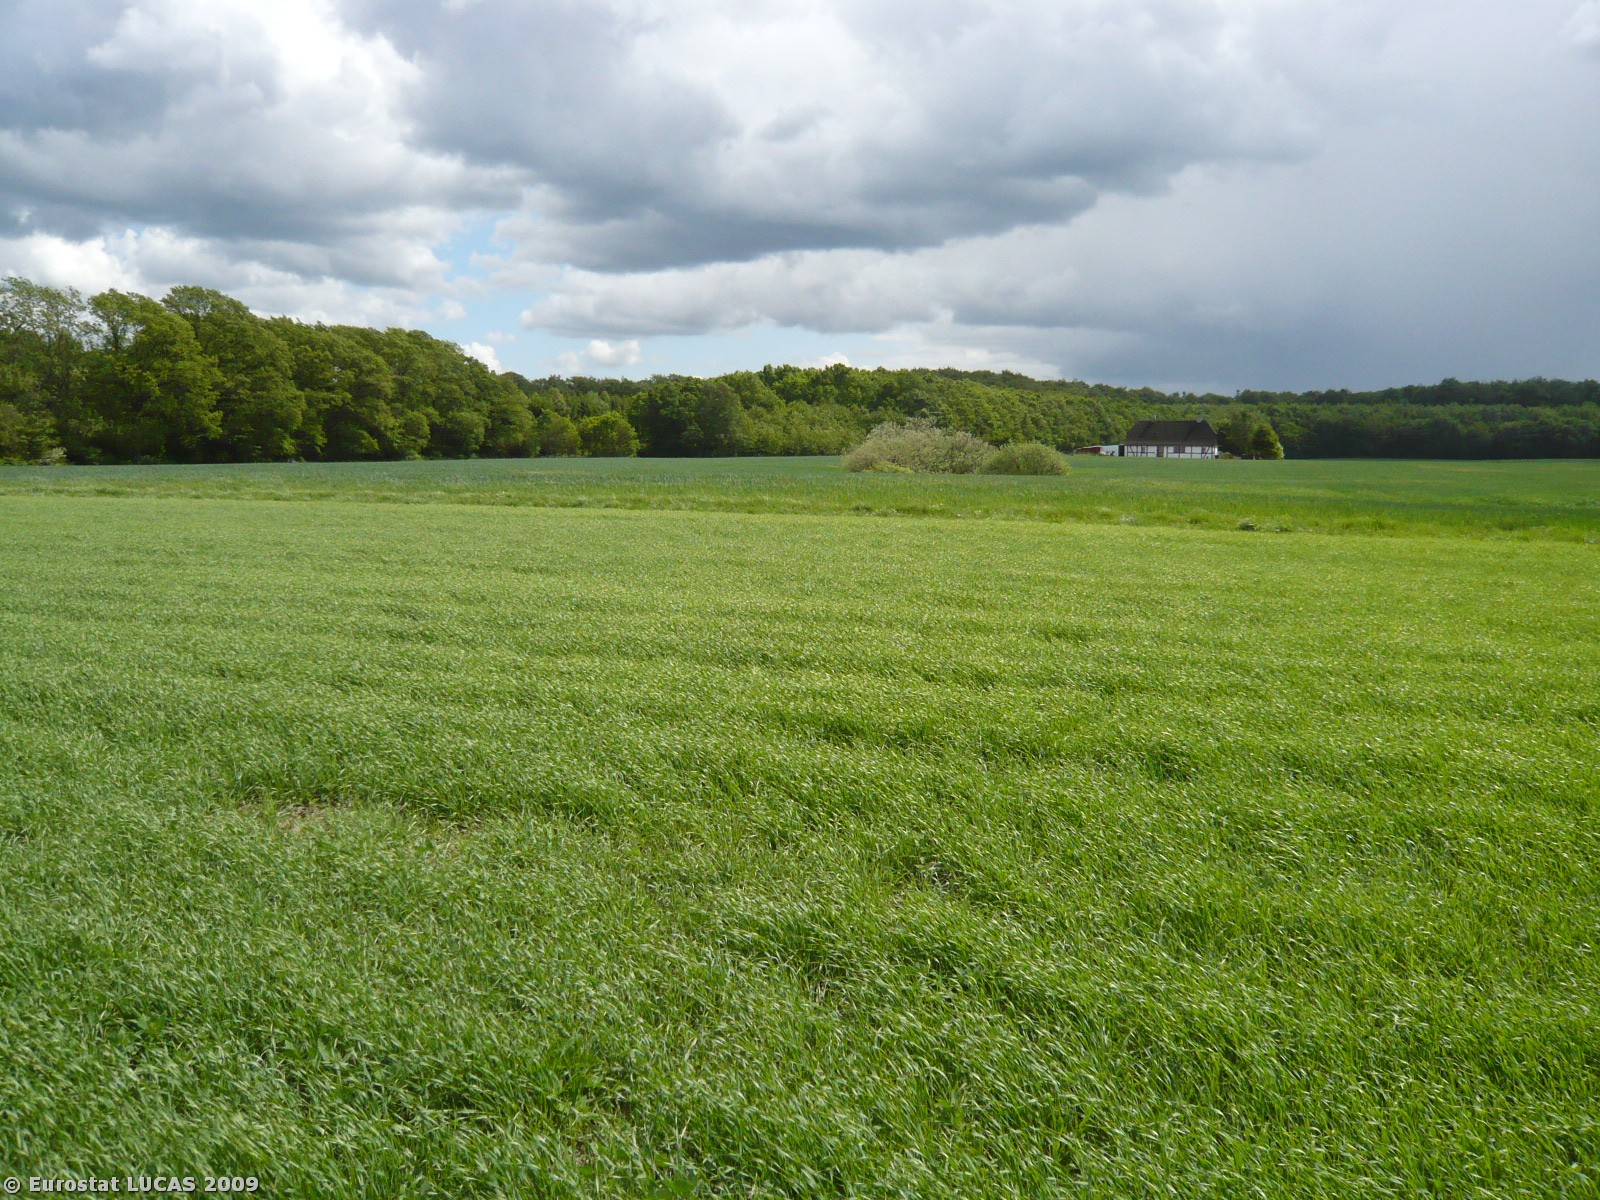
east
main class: Cropland
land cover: Barley
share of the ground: > 75 %
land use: Agriculture (excluding fallow land and kitchen gardens)
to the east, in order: Barley; Grassland without tree/shrub cover; Broadleaved woodland; Fences; Broadleaved woodland
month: May
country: DK
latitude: 55.3145
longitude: 11.6216
